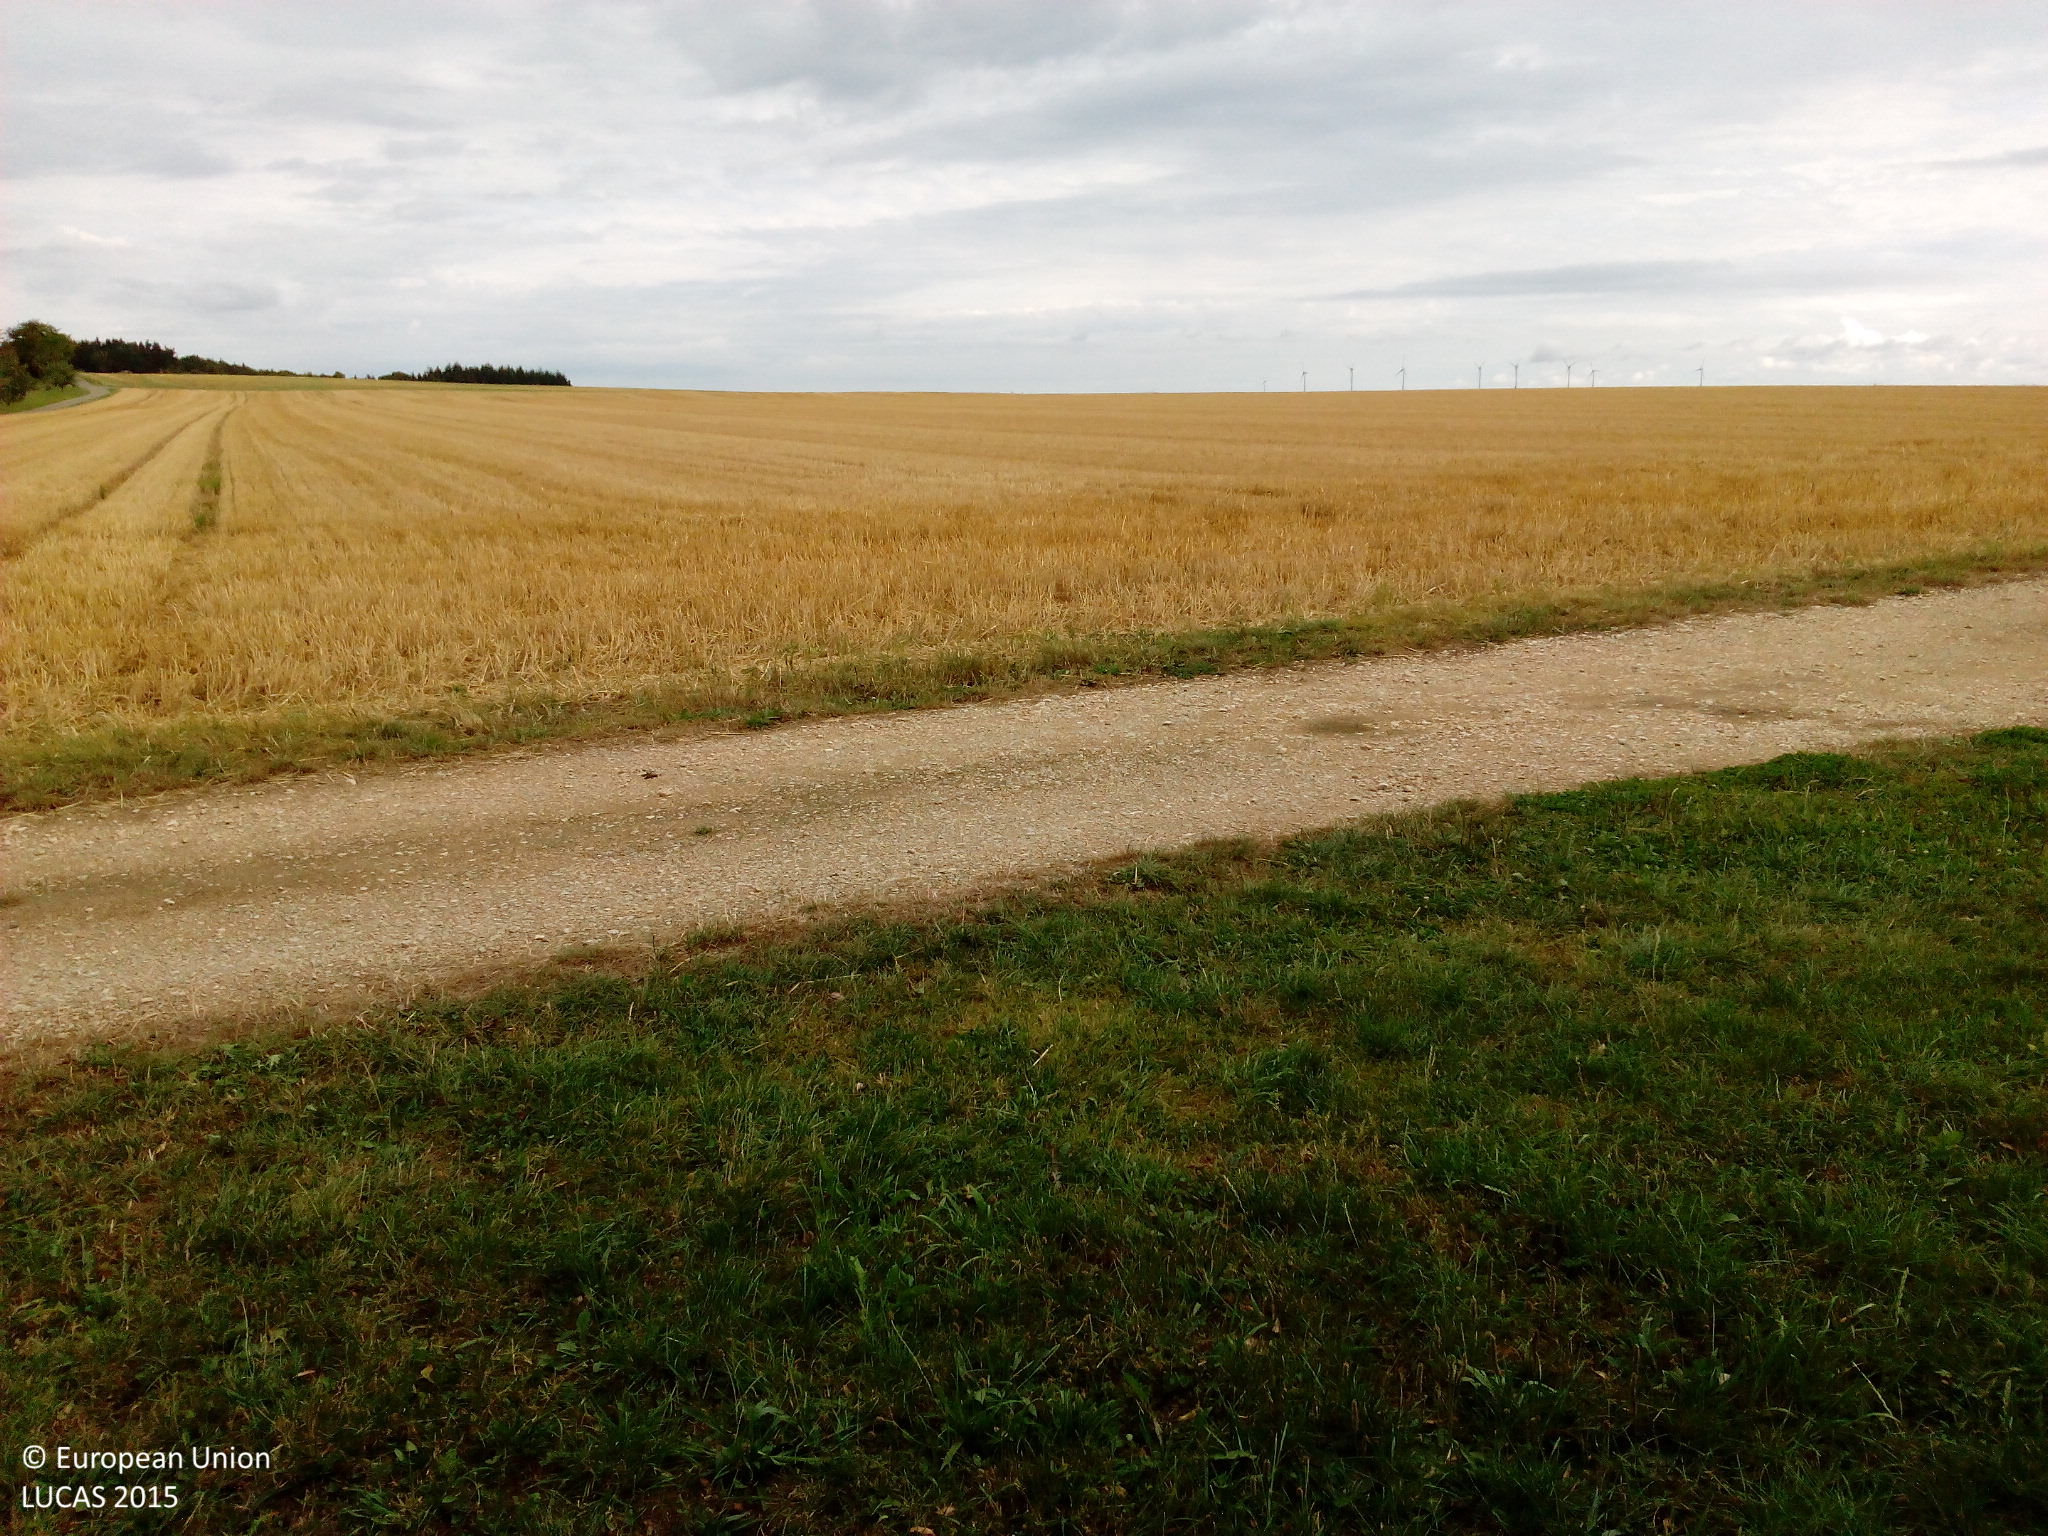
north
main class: Grassland
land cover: Grassland without tree/shrub cover
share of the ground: > 75 %
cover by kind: herbaceous plants 100 %
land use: Agriculture (excluding fallow land and kitchen gardens)
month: August
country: DE
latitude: 48.6554
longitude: 9.9593
